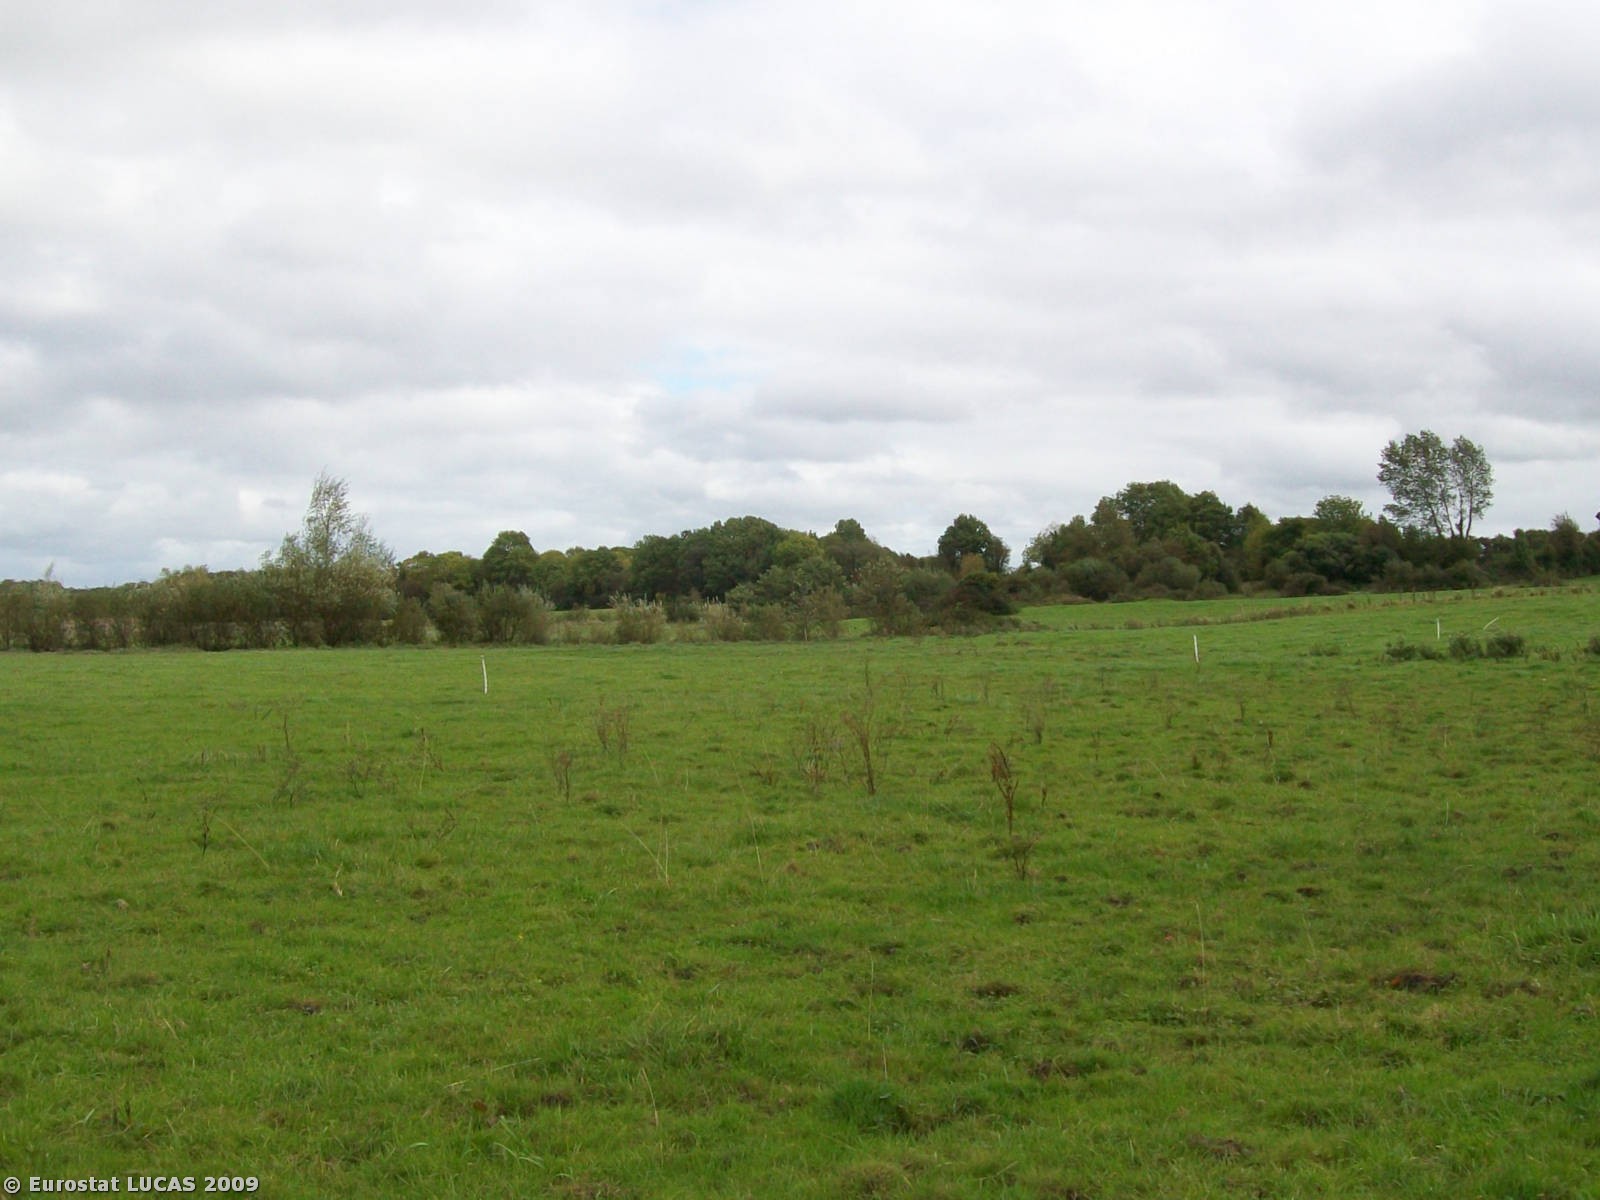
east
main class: Grassland
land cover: Grassland without tree/shrub cover
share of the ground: > 75 %
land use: Agriculture (excluding fallow land and kitchen gardens)
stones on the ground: < 10 %
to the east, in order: Grassland without tree/shrub cover; Fences; Grass margins; Lines of trees; Ditches and canals; Shrubland without tree cover; Fences; Grassland without tree/shrub cover
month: September
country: IE
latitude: 53.2027
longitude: -7.9750
